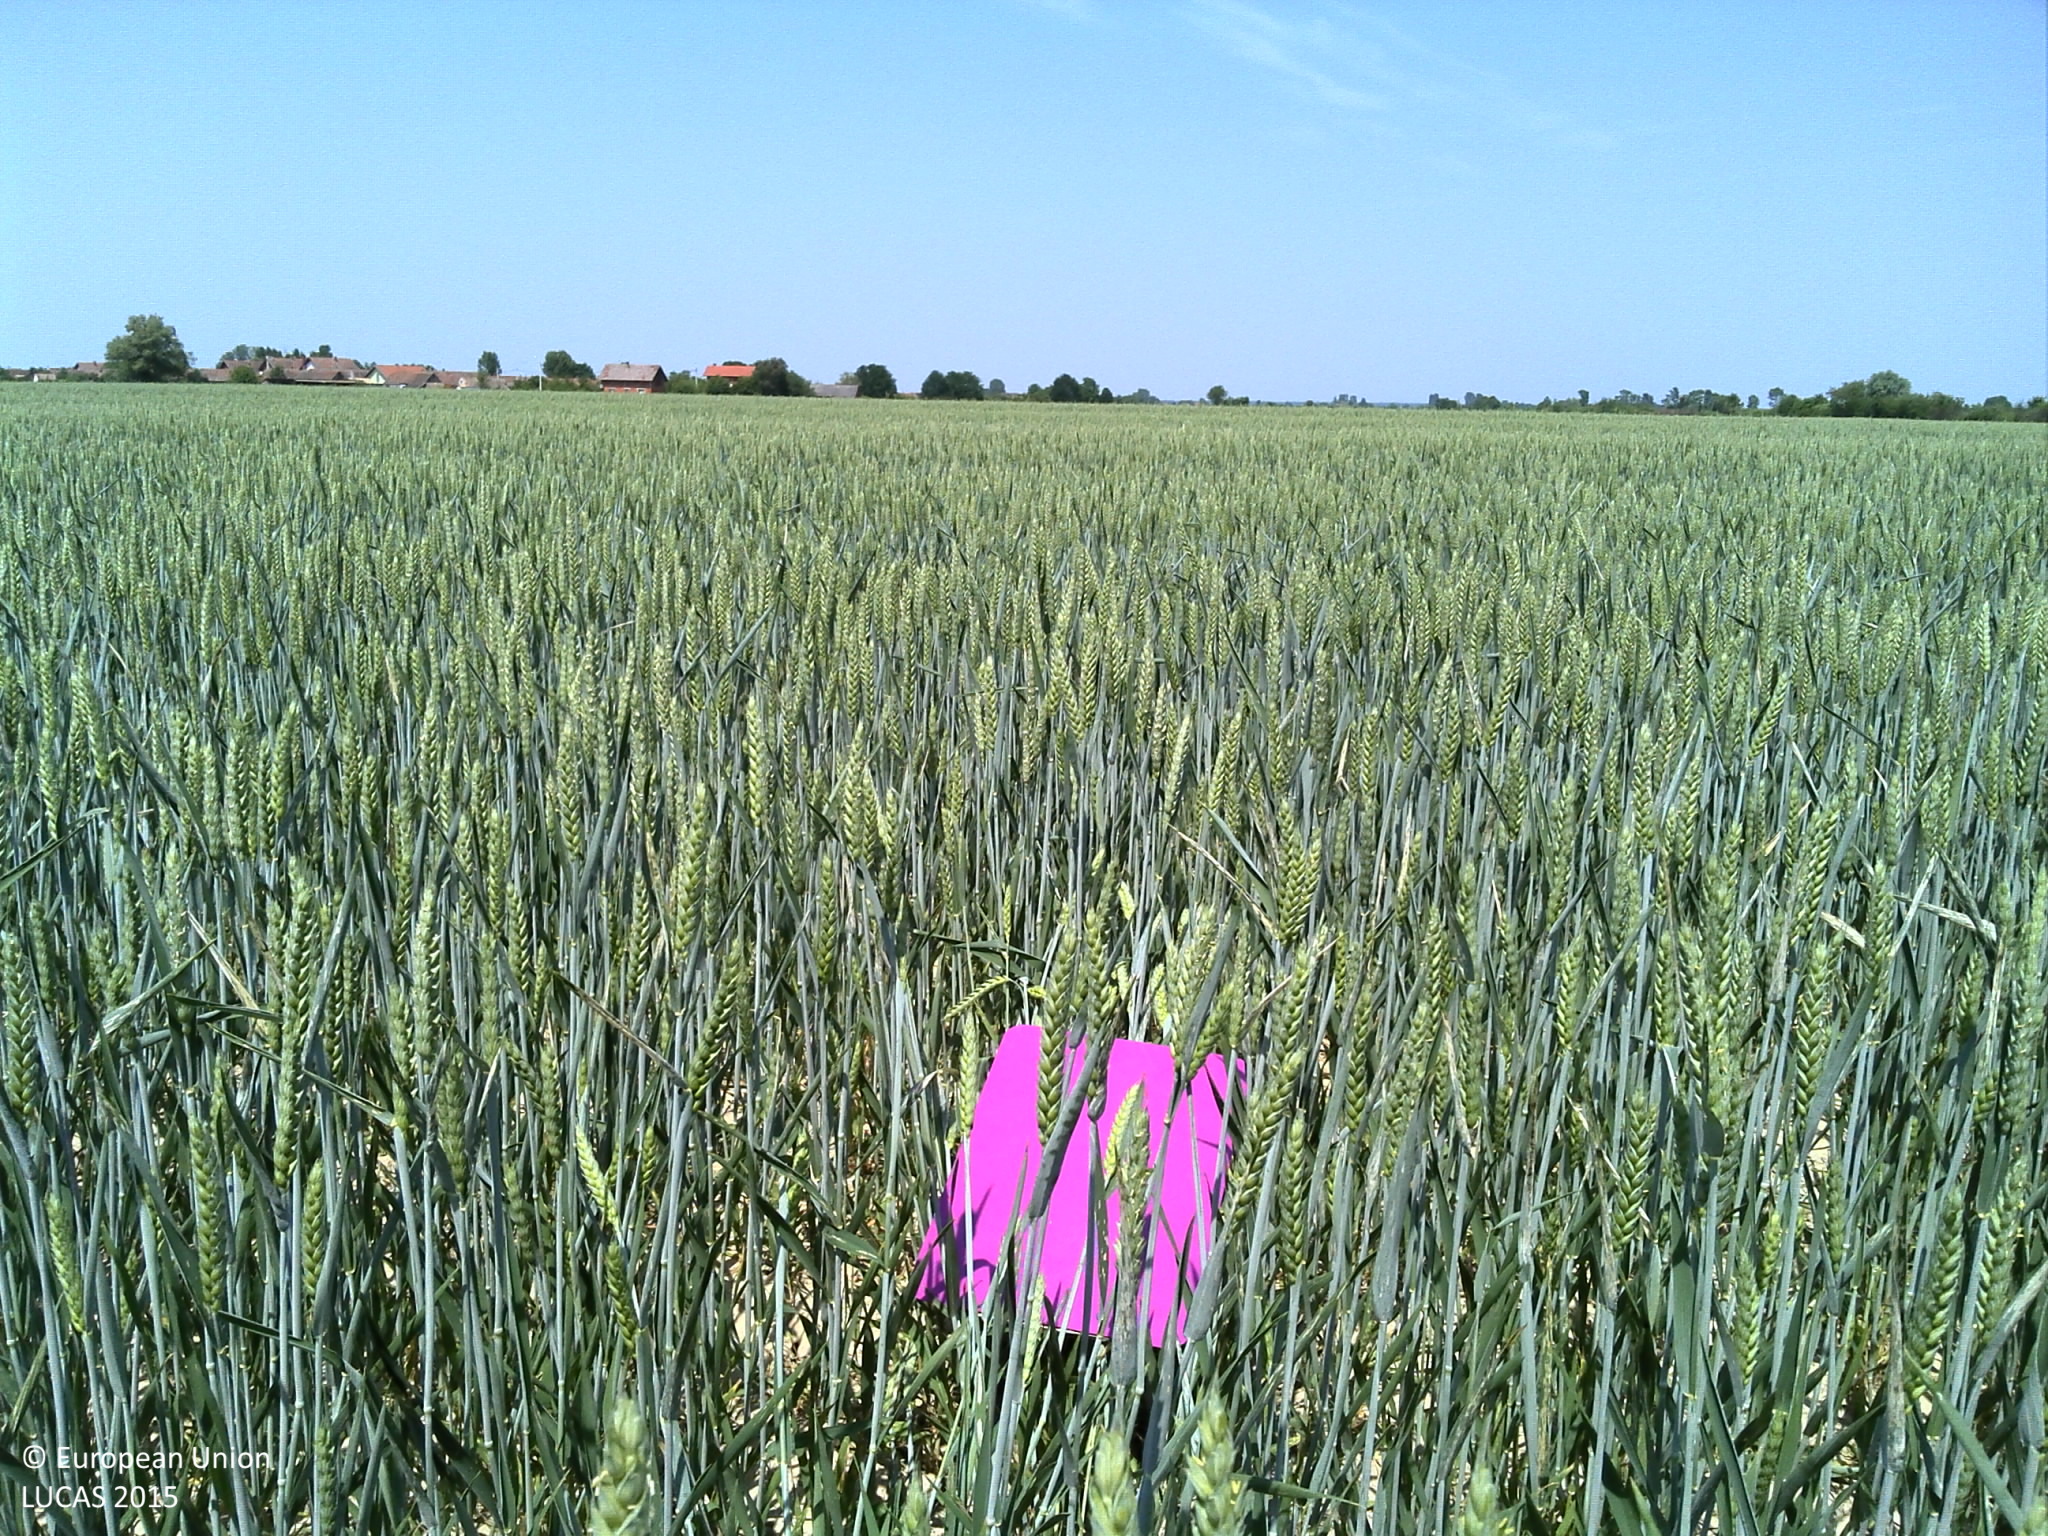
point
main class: Cropland
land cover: Common wheat
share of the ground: > 75 %
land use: Agriculture (excluding fallow land and kitchen gardens)
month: May
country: HR
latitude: 45.5142
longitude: 18.1587
